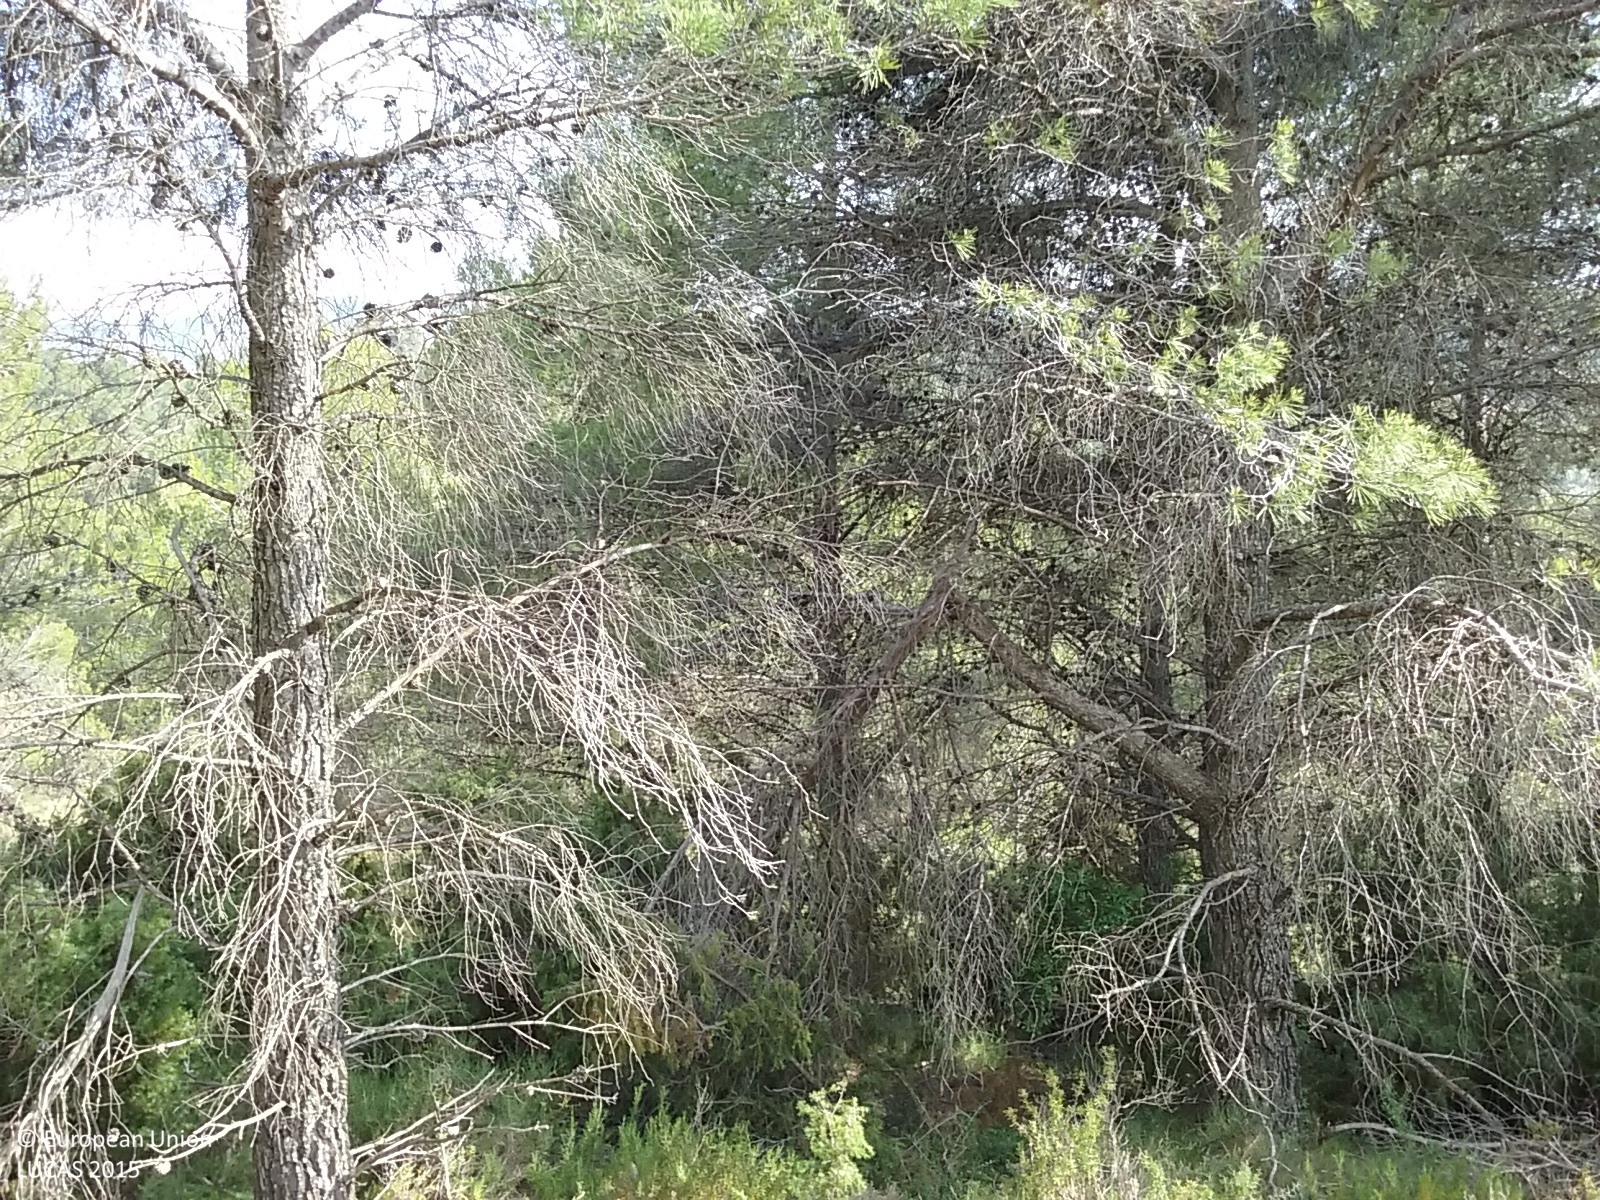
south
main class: Woodland
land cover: Pine dominated coniferous woodland
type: coniferous forest of the mediterranean region
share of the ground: 50 - 75 %
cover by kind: coniferous forest trees 70 %, shrubs 25 %, unconsolidated bare surface 5 %
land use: Semi-natural and natural areas not in use
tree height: > 5 m
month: June
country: ES
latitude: 40.9540
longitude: 0.3332
